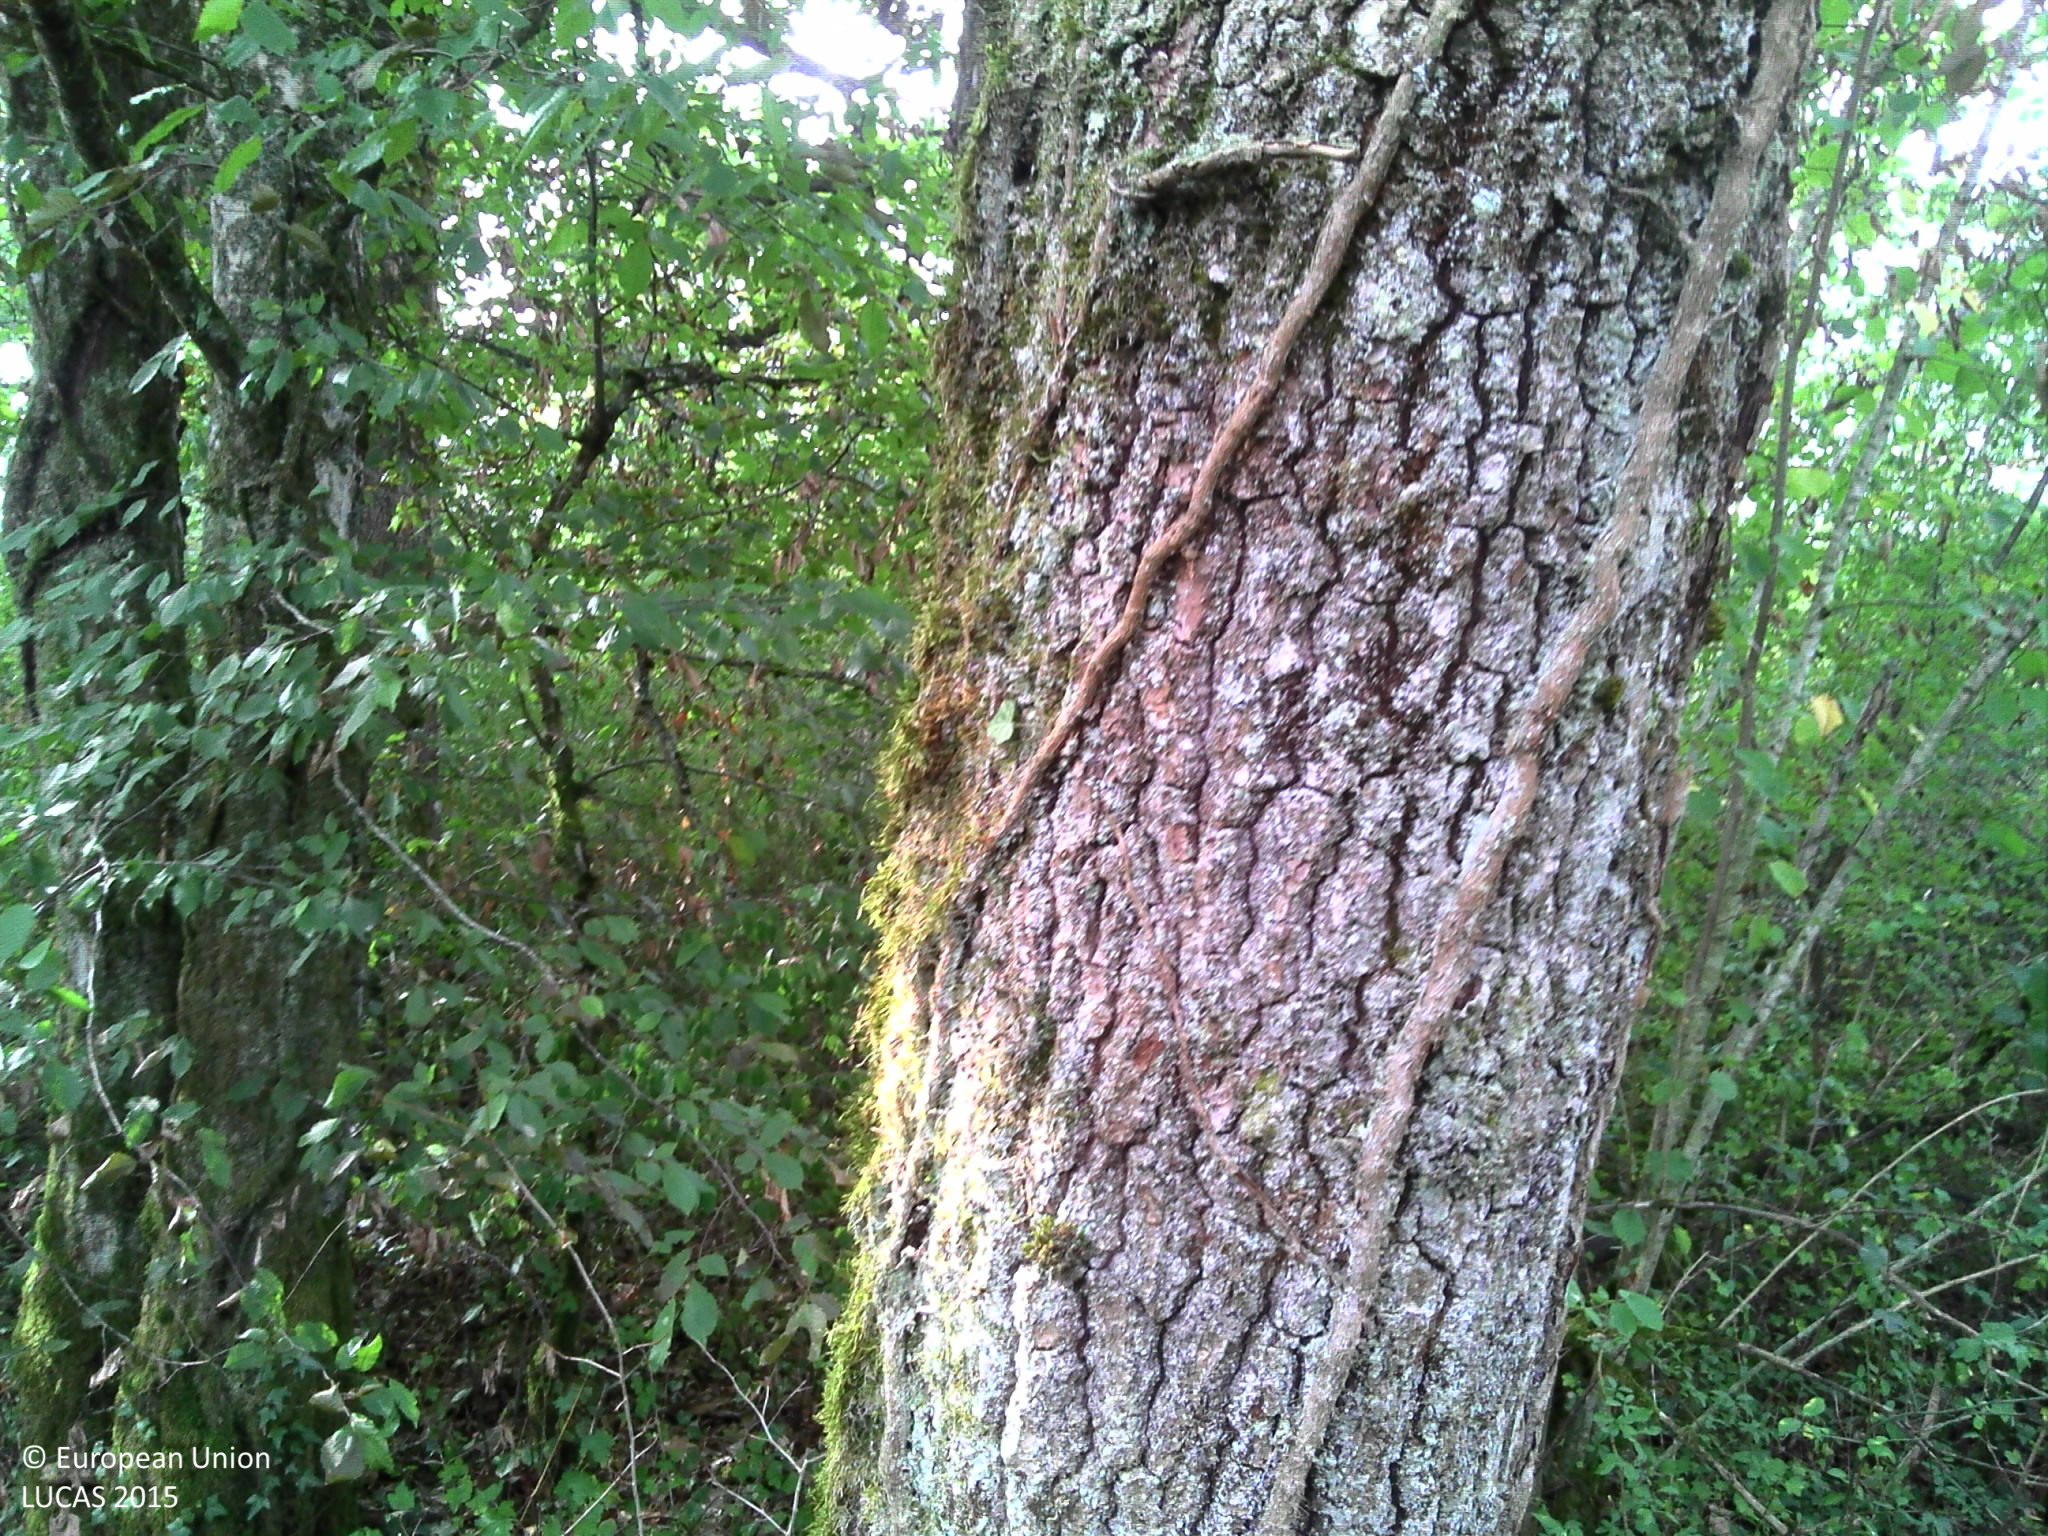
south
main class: Woodland
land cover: Broadleaved woodland
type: mesophytic deciduous forest
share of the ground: > 75 %
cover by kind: broadleaved forest trees 90 %, herbaceous plants 5 %, lichens and mosses 5 %
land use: Forestry
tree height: > 5 m
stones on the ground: 25 - 50 %
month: September
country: FR
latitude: 47.6535
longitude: 4.8737
